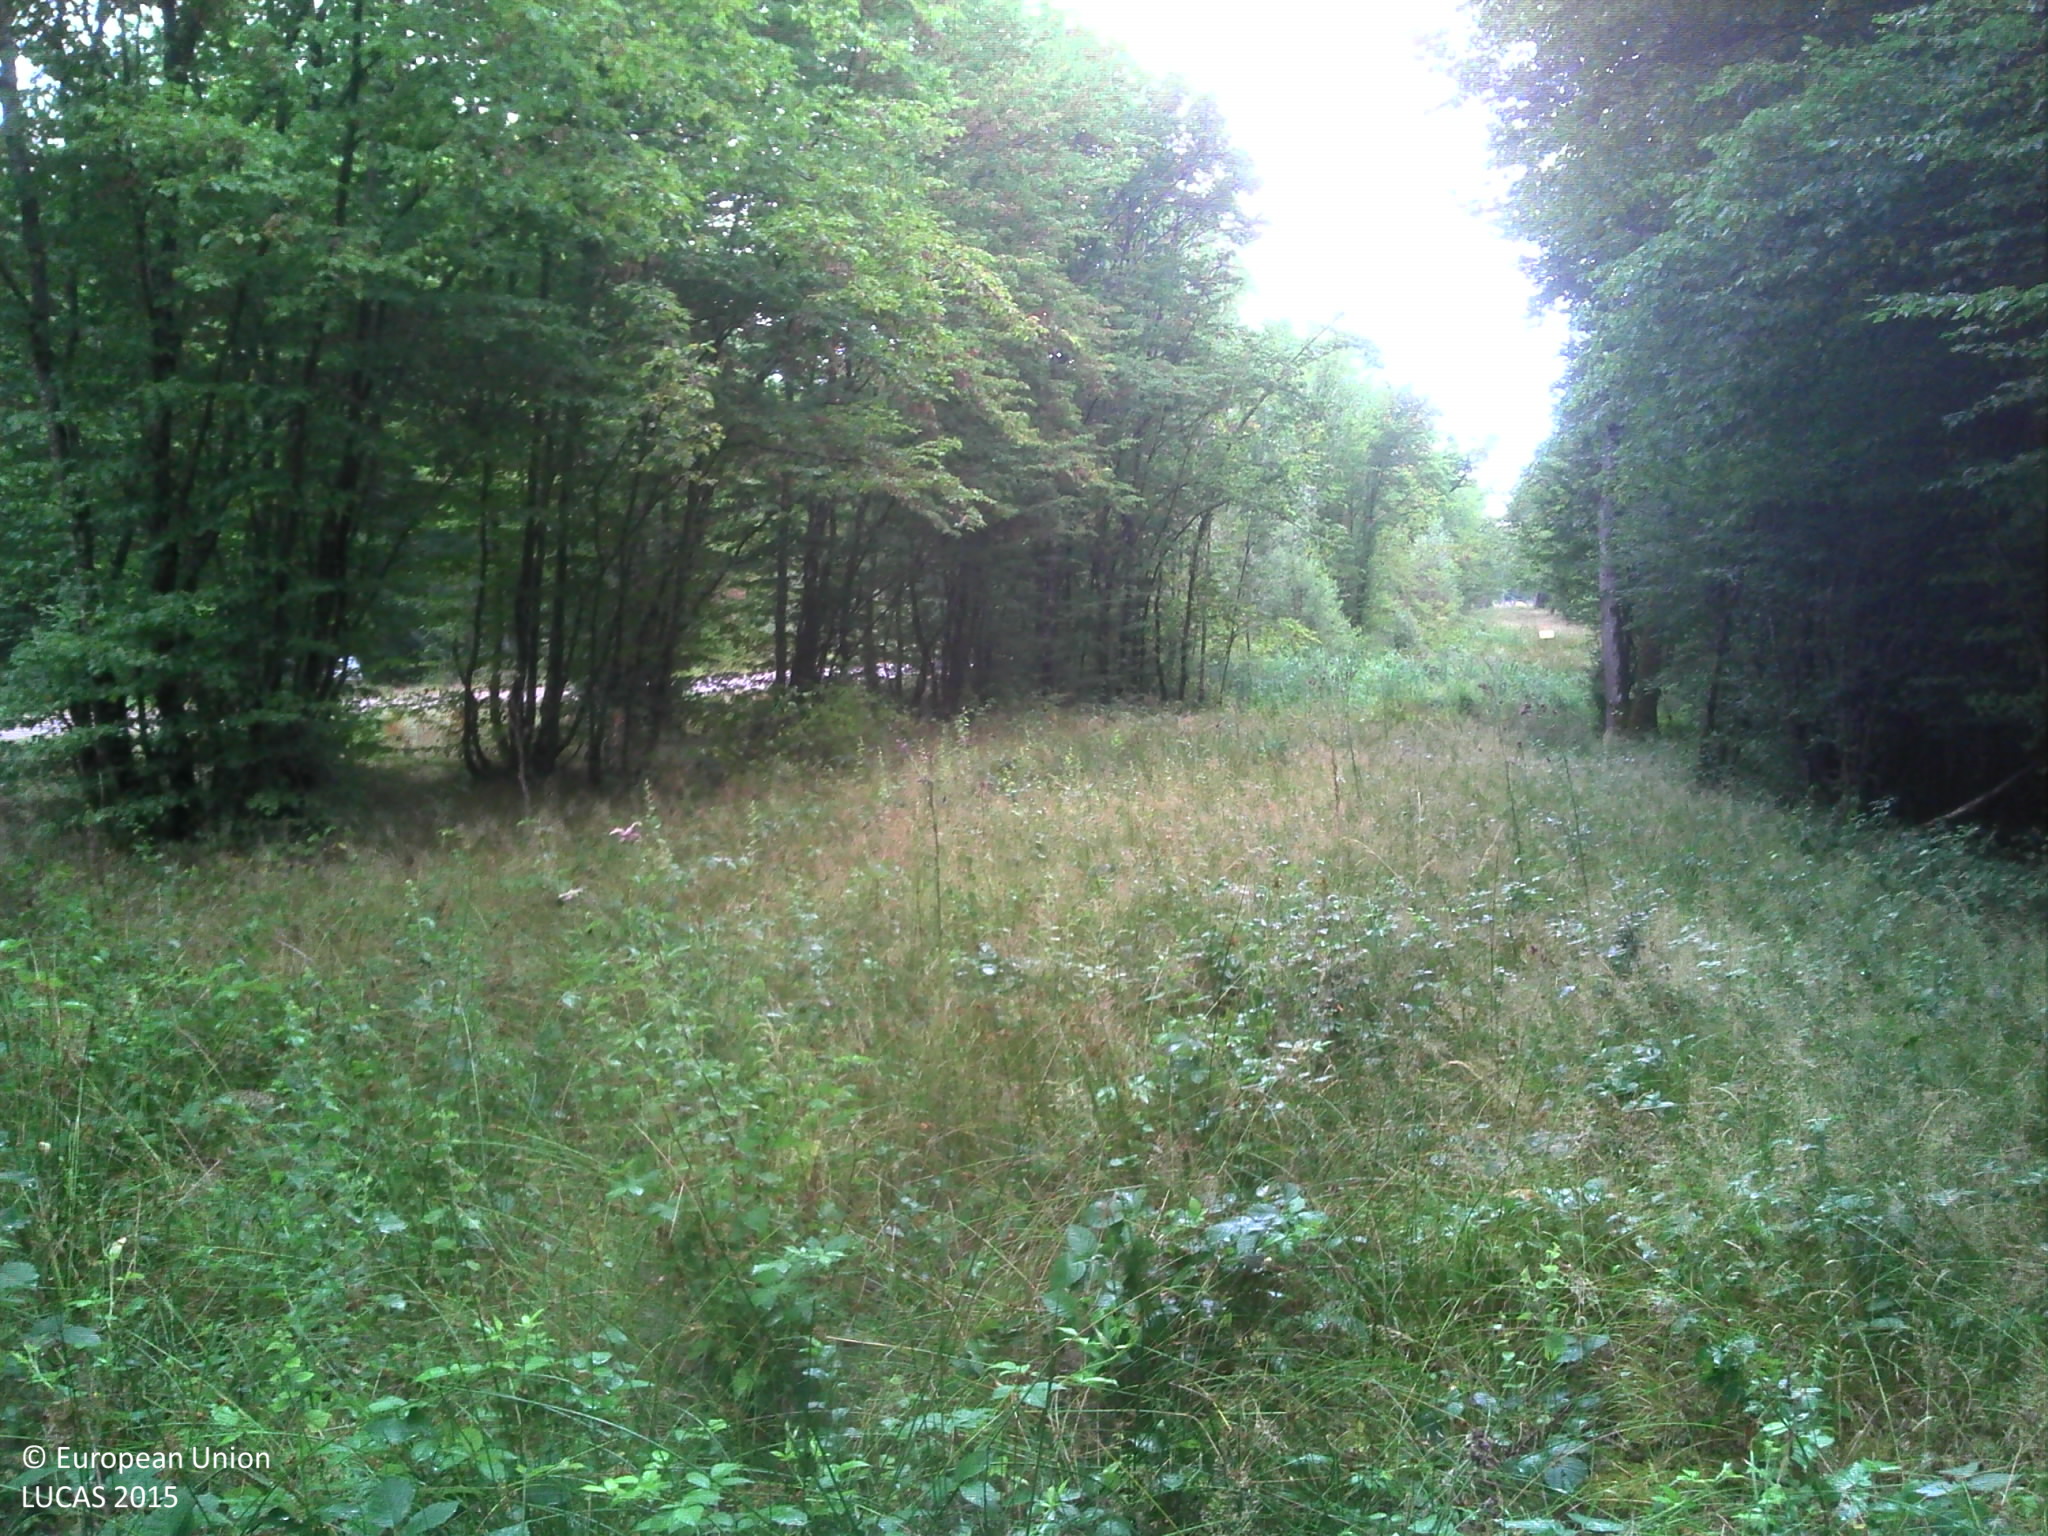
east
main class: Grassland
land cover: Grassland with sparse tree/shrub cover
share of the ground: > 75 %
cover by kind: herbaceous plants 95 %, broadleaved forest trees 5 %
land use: Electricity, gas and thermal power distribution
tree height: > 5 m
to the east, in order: Grassland with sparse tree/shrub cover; Ditches and canals; Grass margins; Paved roads, cycling and walking lanes; Grass margins; Ditches and canals; Broadleaved woodland
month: July
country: FR
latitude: 46.8920
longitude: 4.7904
